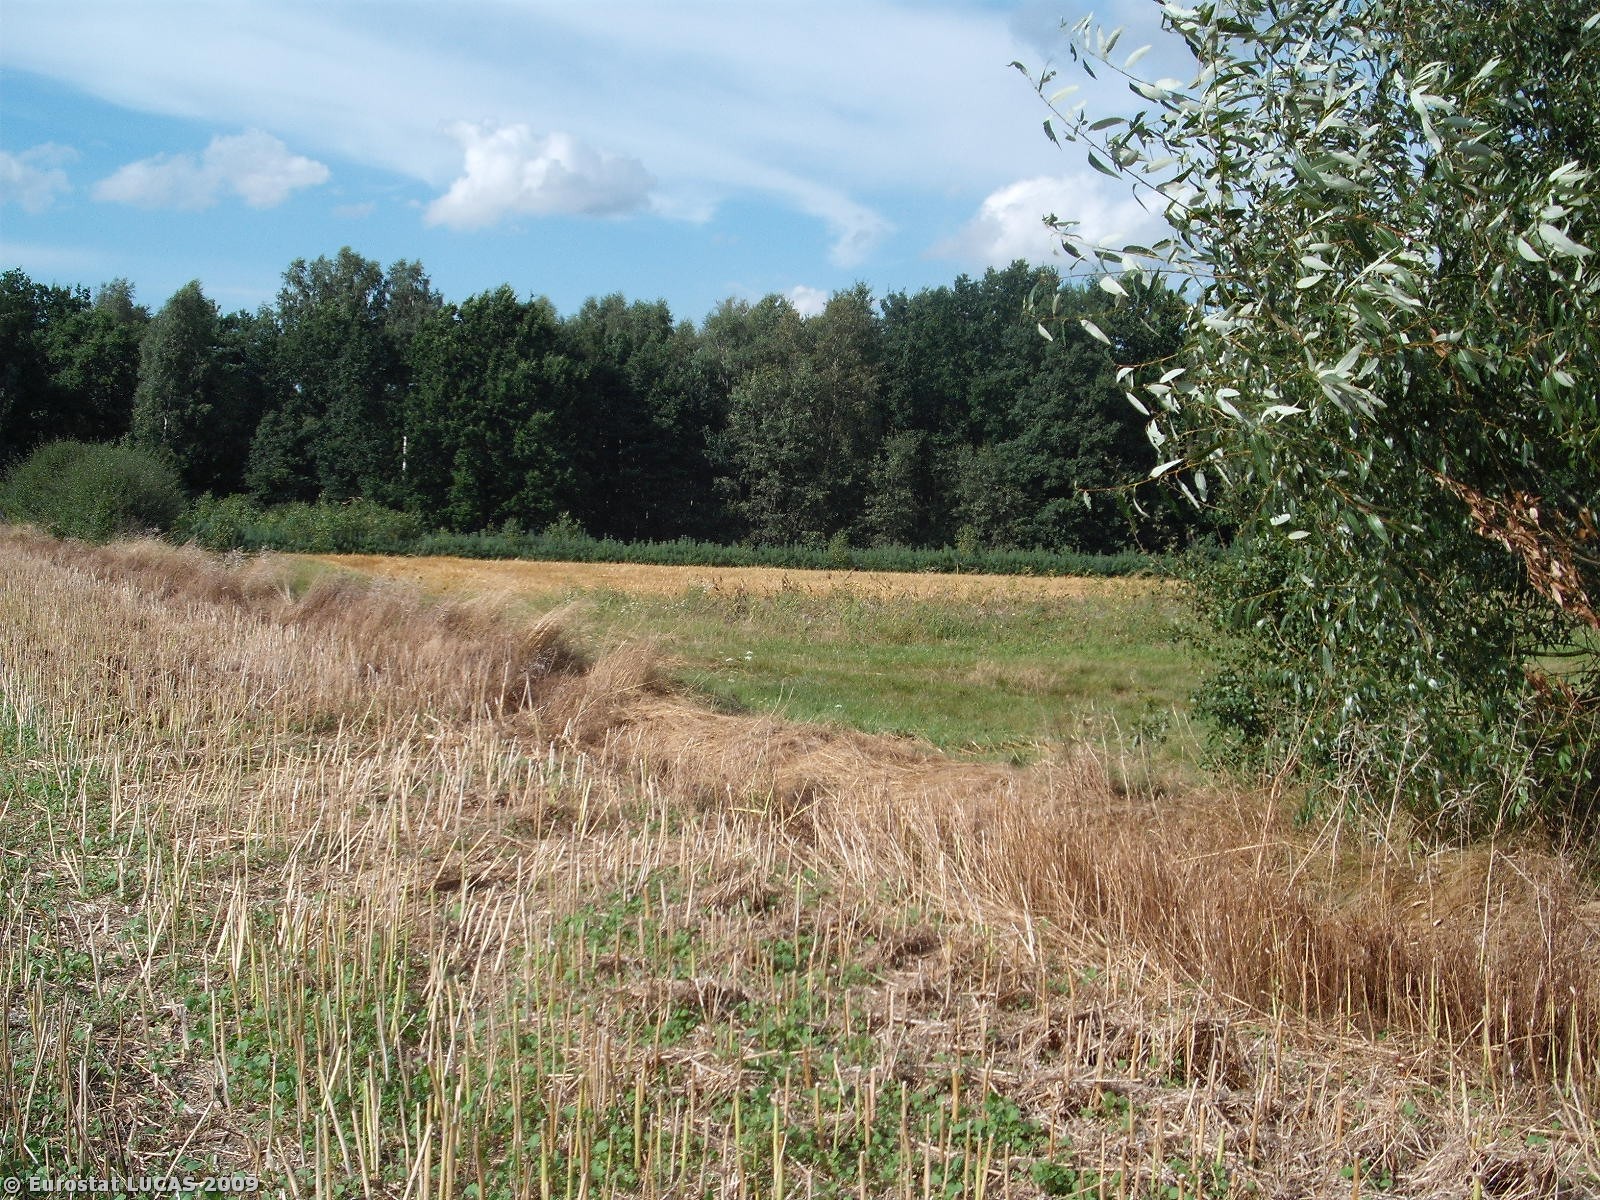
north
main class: Cropland
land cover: Other fibre and oleaginous crops
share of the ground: < 10 %
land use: Agriculture (excluding fallow land and kitchen gardens)
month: August
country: PL
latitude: 51.8408
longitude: 21.6208
